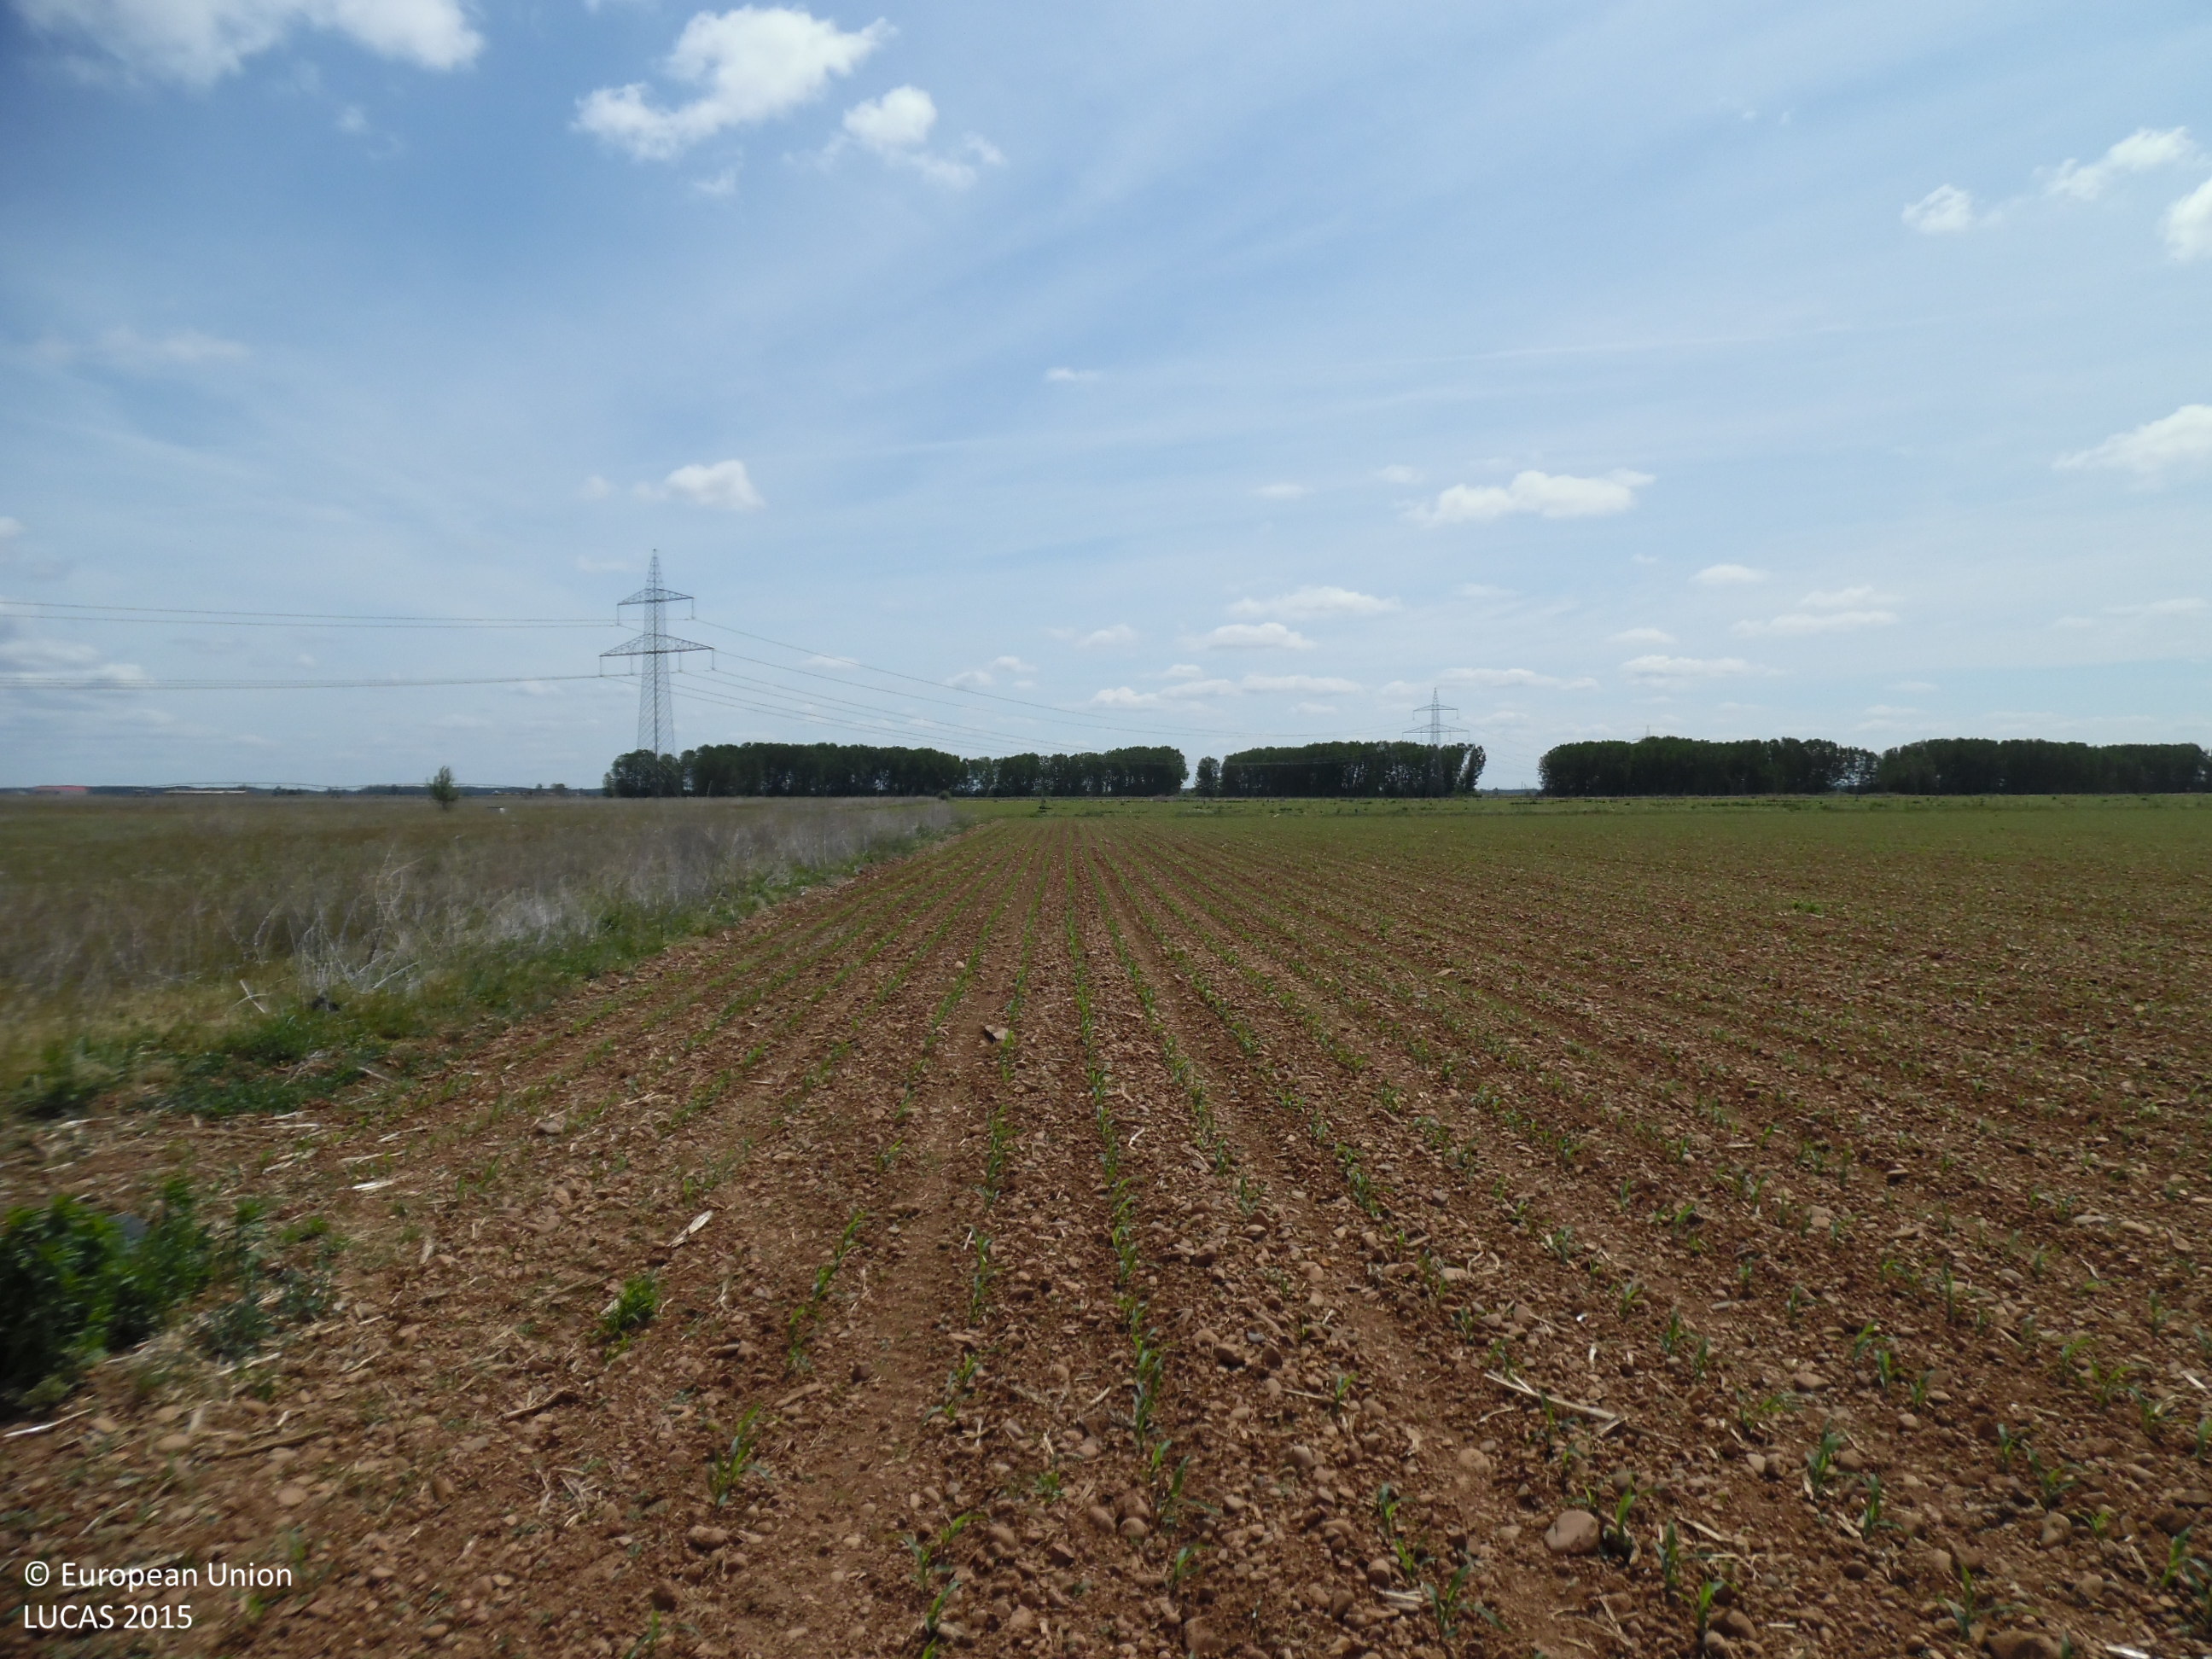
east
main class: Cropland
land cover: Maize
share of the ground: < 10 %
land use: Agriculture (excluding fallow land and kitchen gardens)
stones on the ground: 10 - 25 %
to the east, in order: Maize; Grass margins; Maize
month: May
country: ES
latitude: 42.2091
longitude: -5.7082
